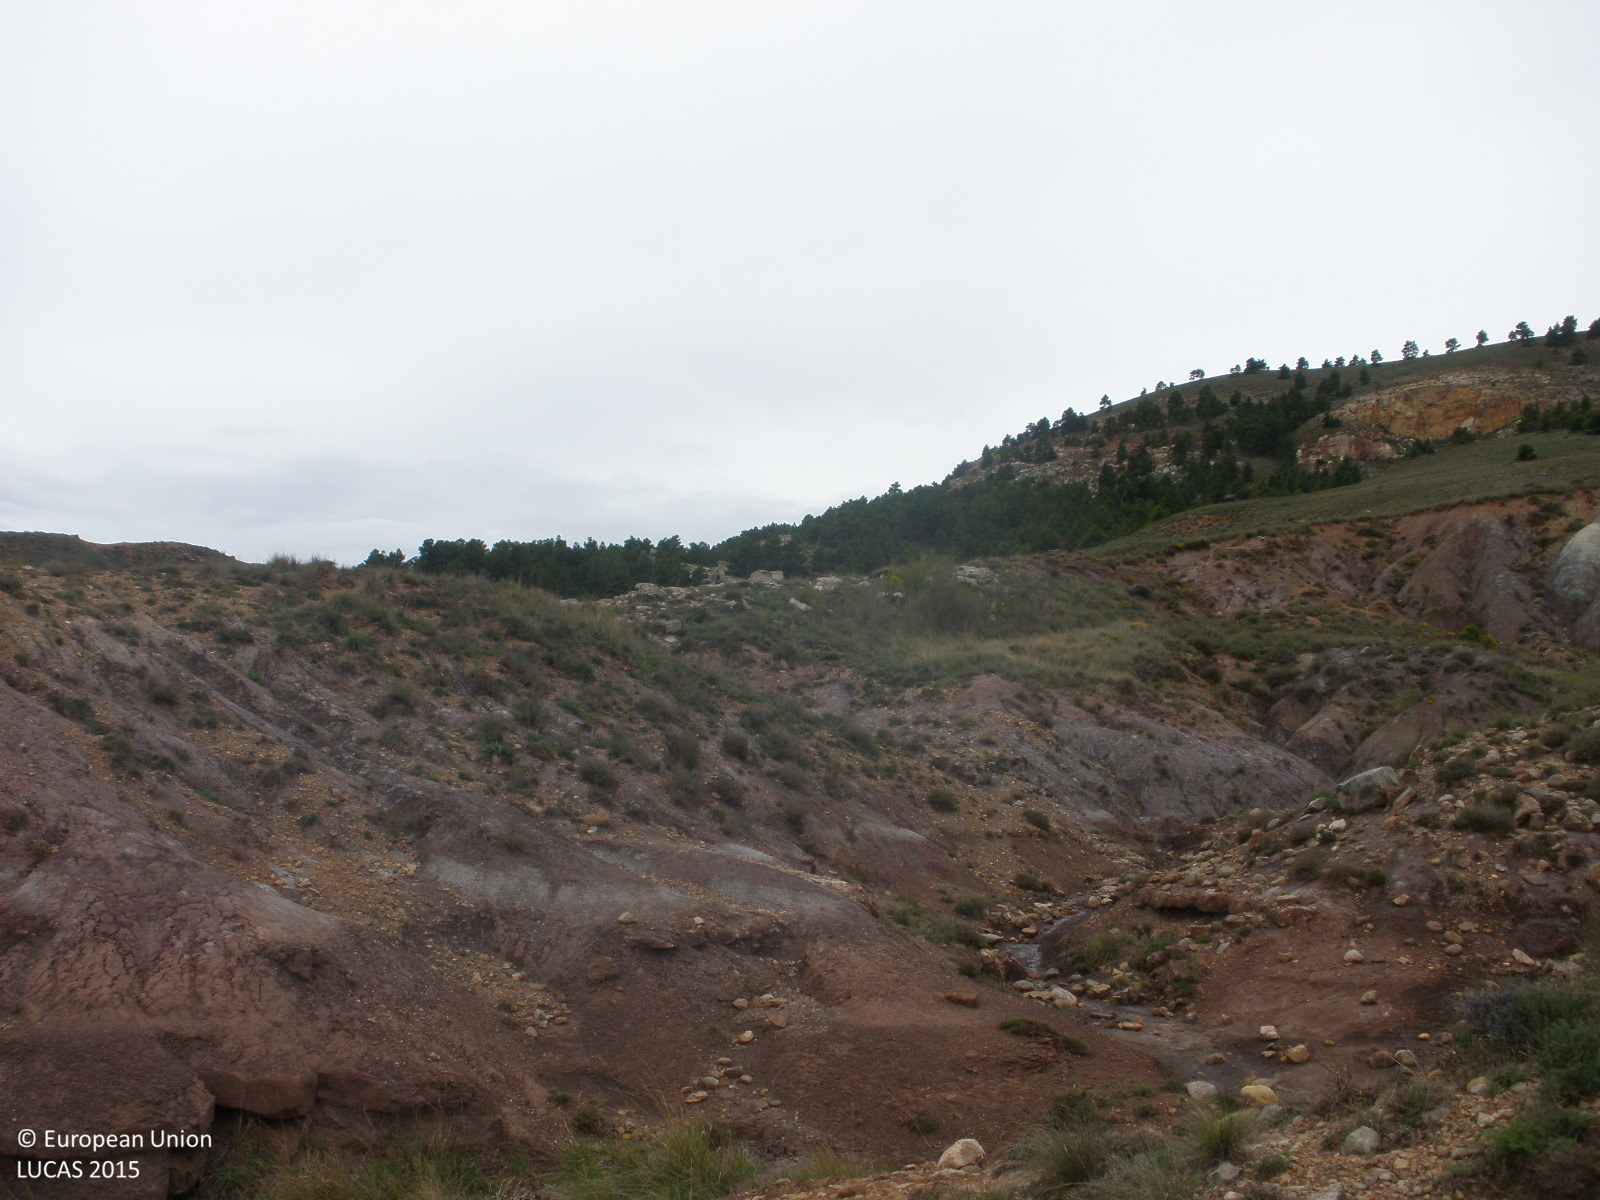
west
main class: Shrubland
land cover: Shrubland without tree cover
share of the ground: 25 - 50 %
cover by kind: consolidated bare surface 50 %, shrubs 30 %, herbaceous plants 20 %
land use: Semi-natural and natural areas not in use
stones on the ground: 10 - 25 %
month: May
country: ES
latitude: 40.5609
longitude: -0.8175
